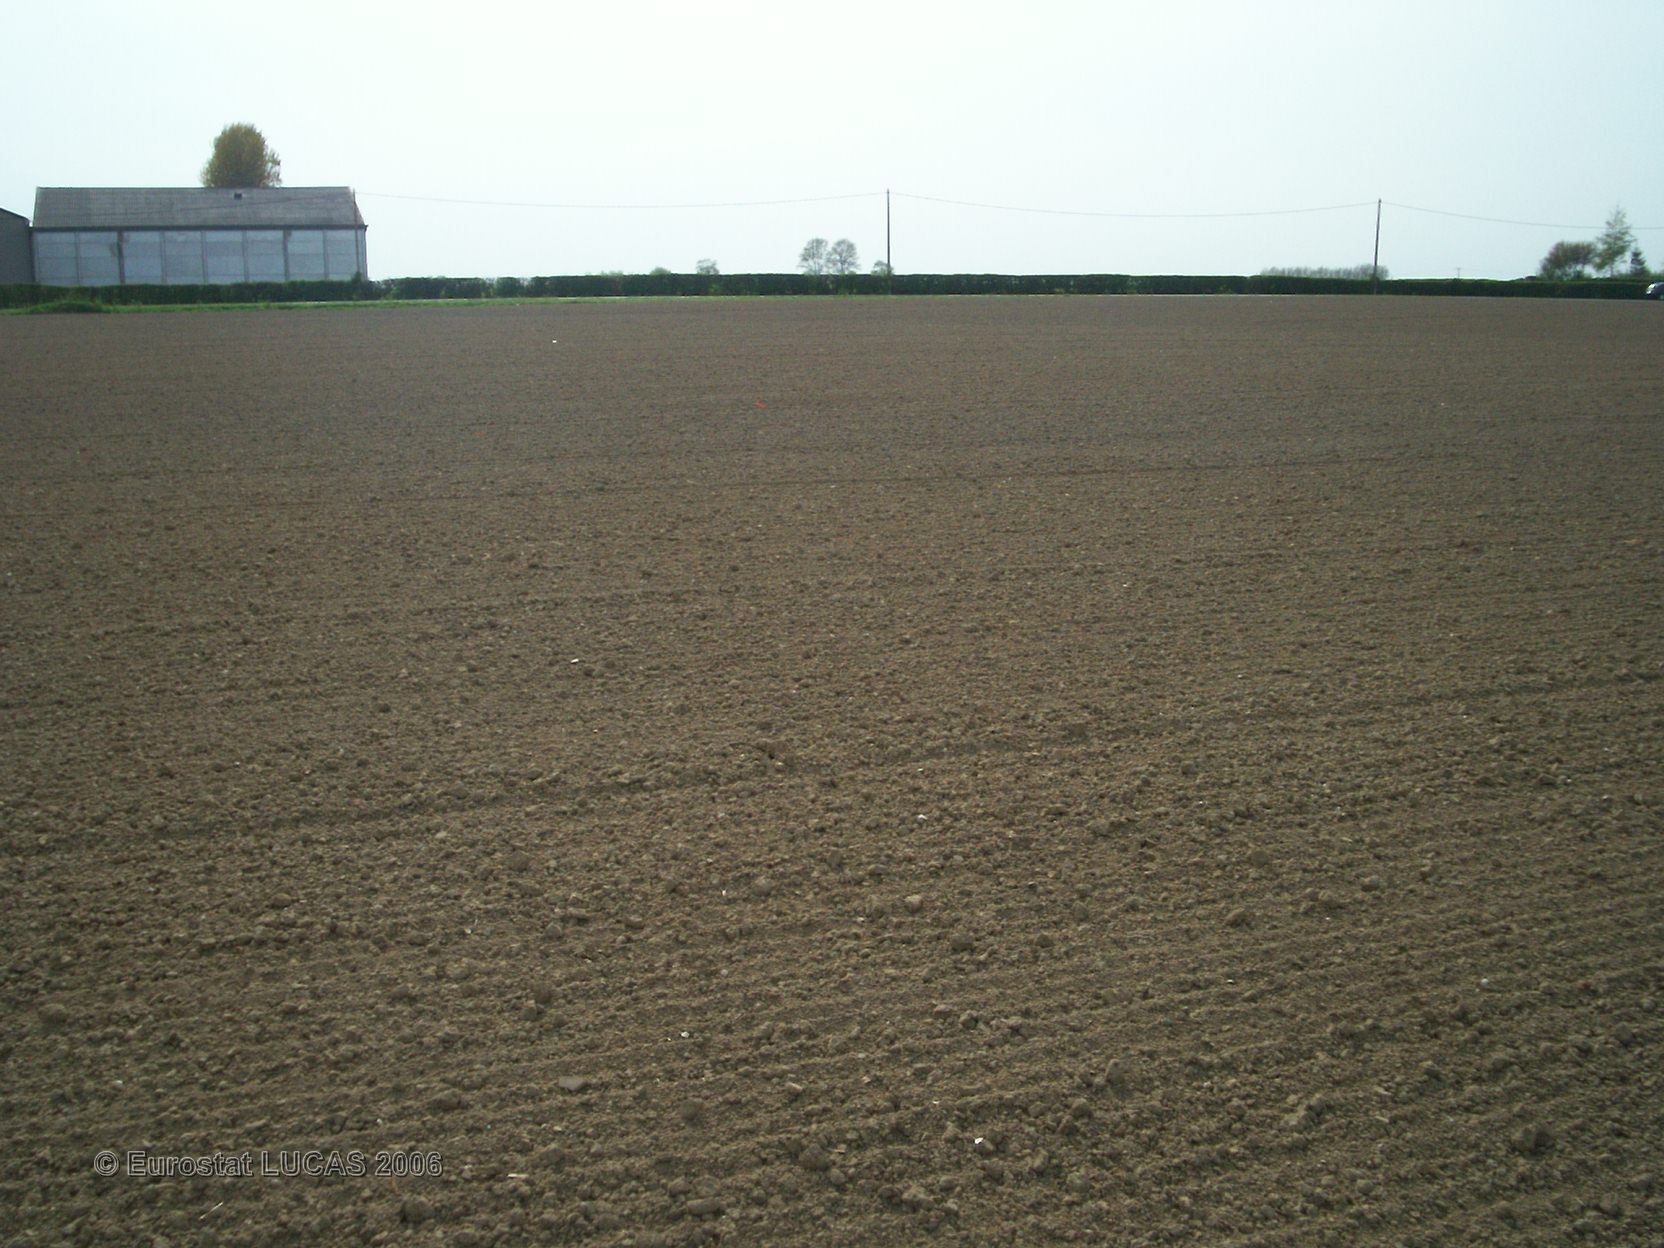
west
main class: Cropland
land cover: Dry pulses
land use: Agriculture (excluding fallow land and kitchen gardens)
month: May
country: FR
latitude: 50.9475
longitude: 2.4860
